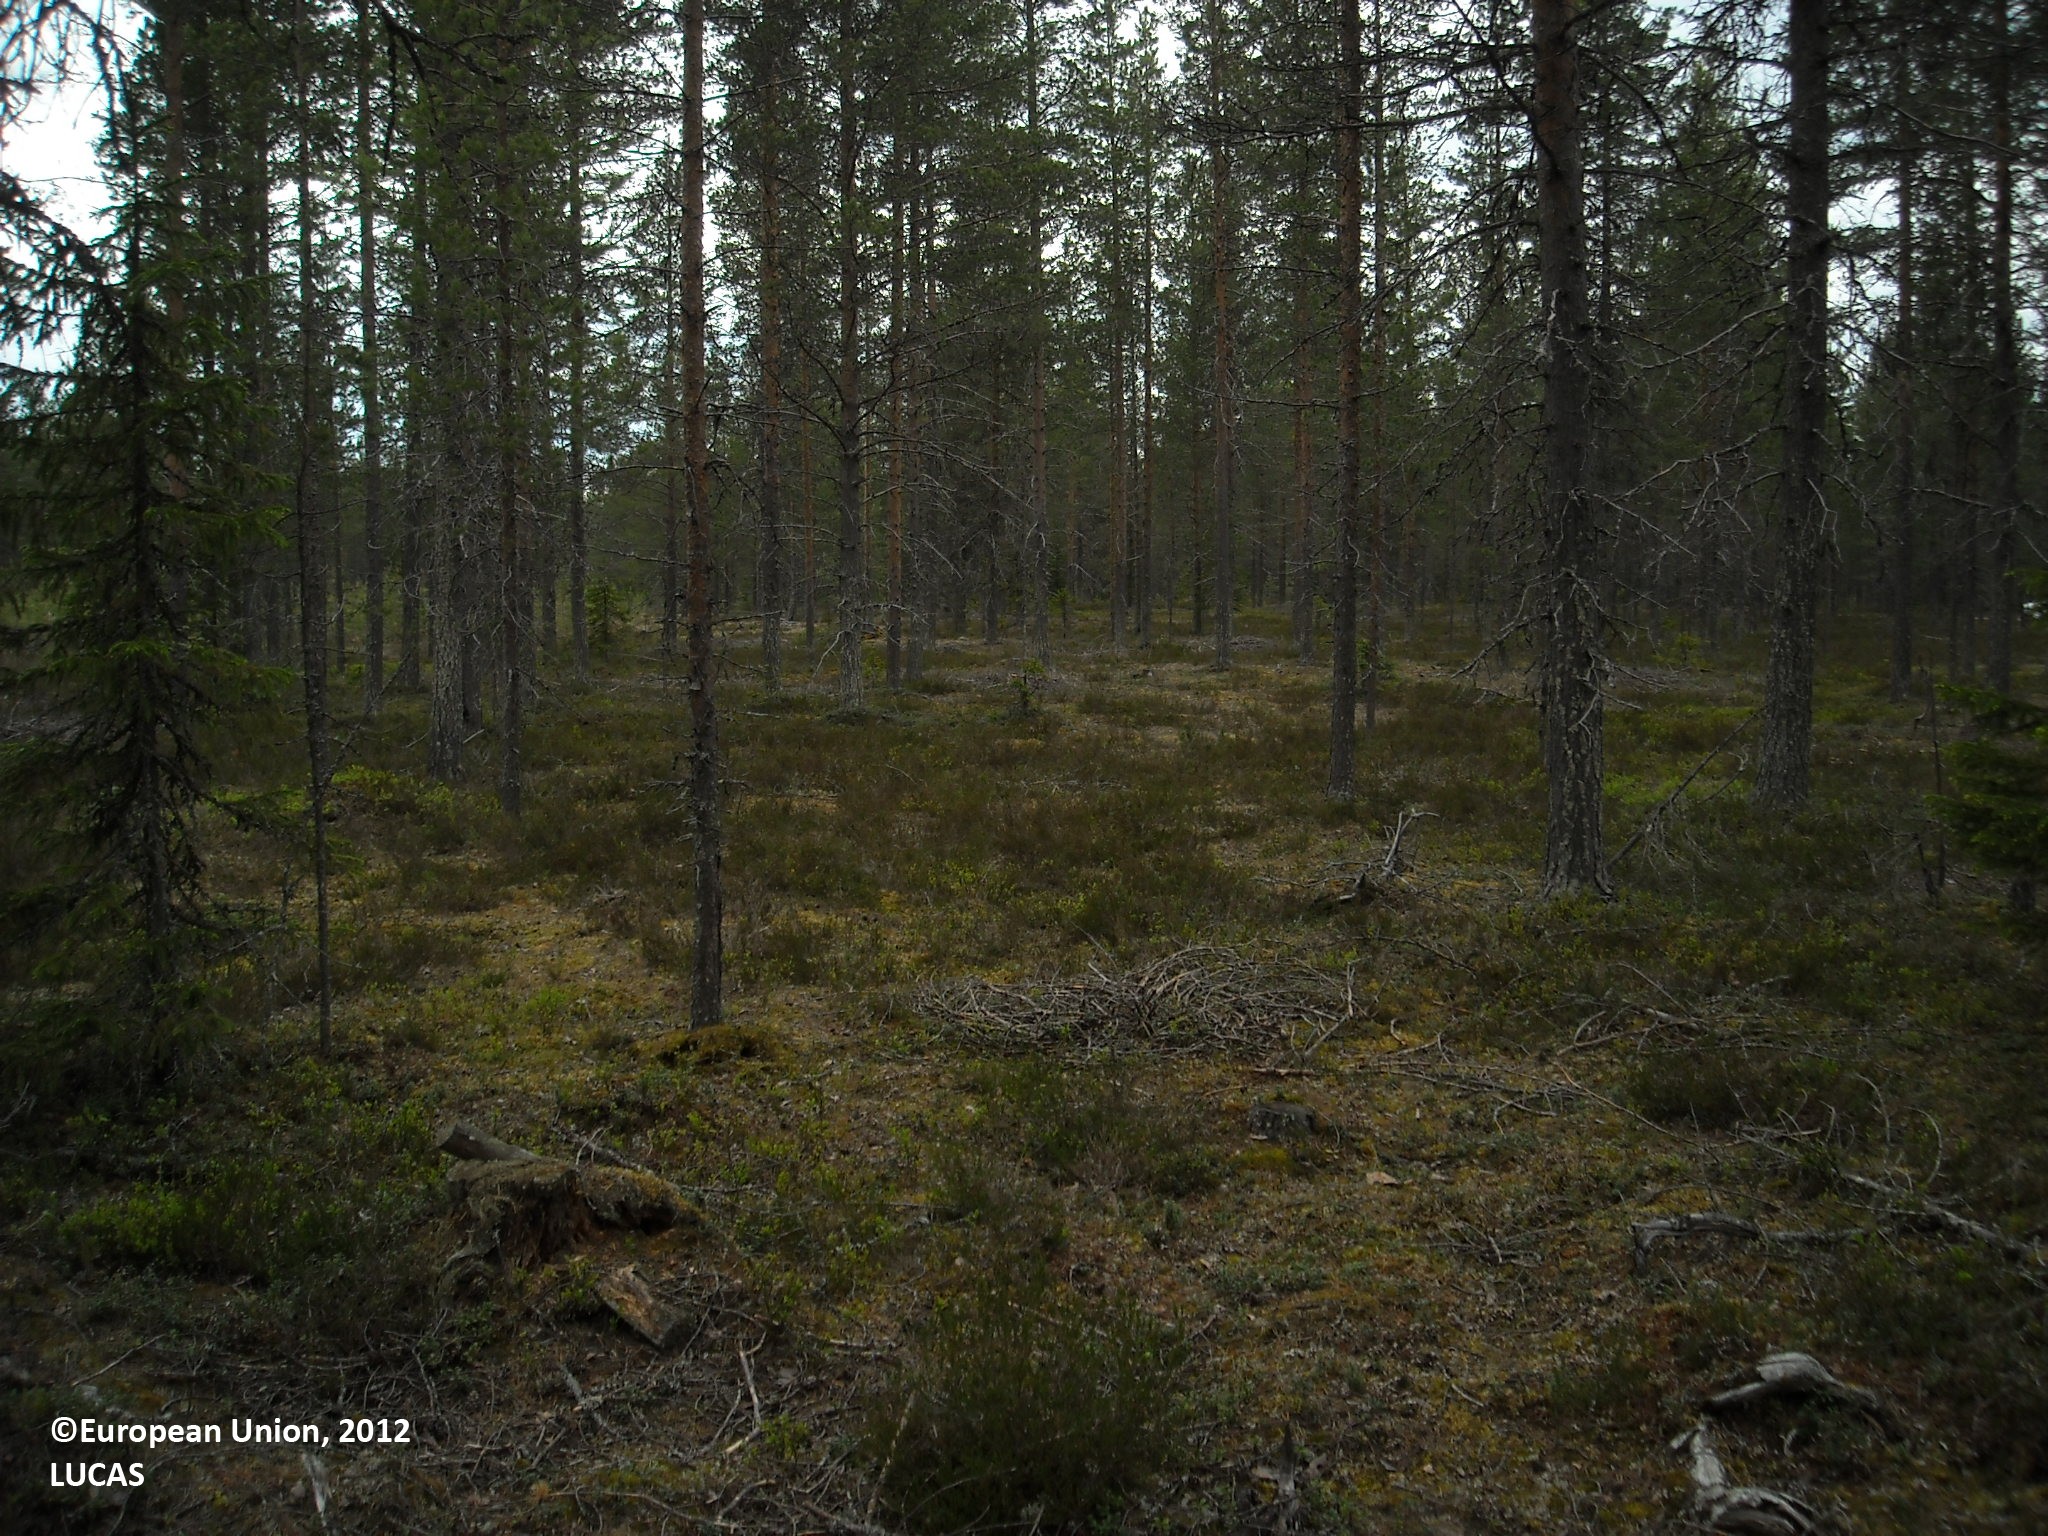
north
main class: Woodland
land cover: Pine dominated coniferous woodland
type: boreal forest
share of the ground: 50 - 75 %
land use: Forestry
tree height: > 5 m
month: June
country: FI
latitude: 65.5469
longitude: 27.9162
